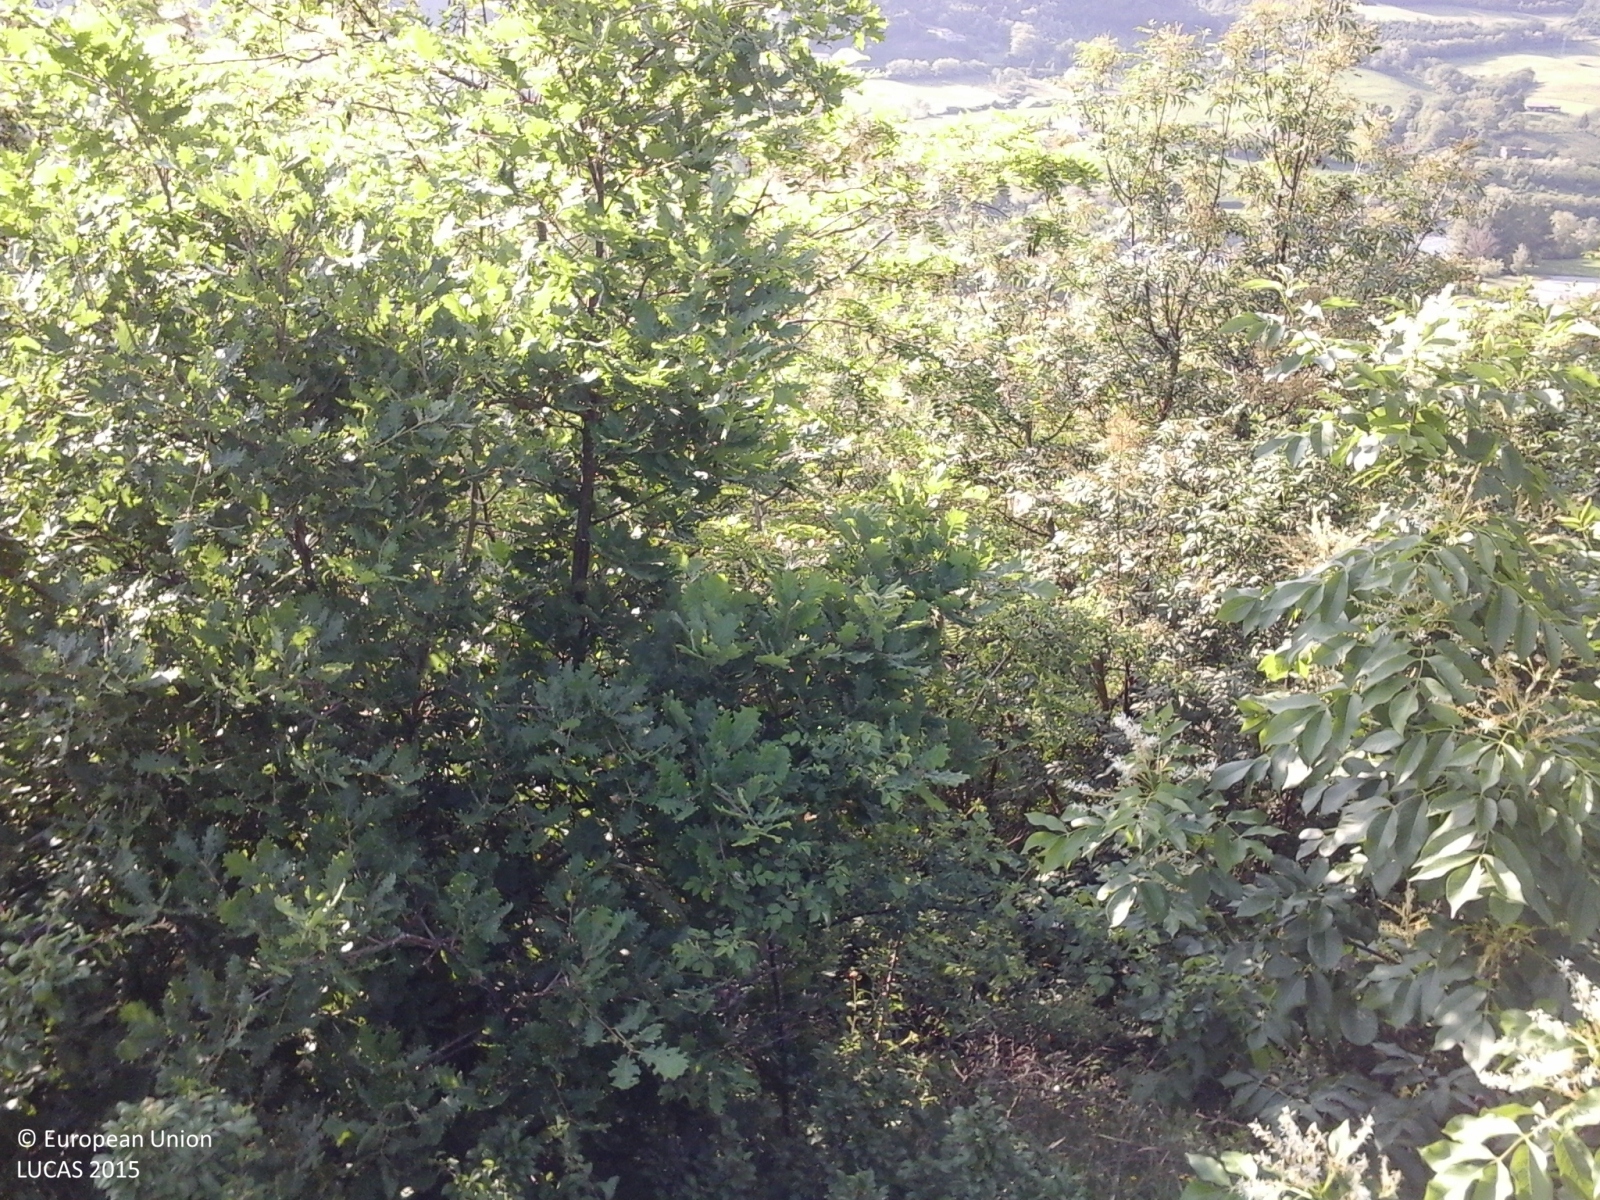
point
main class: Woodland
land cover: Broadleaved woodland
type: mesophytic deciduous forest
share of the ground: > 75 %
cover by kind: broadleaved forest trees 100 %
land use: Forestry
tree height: > 5 m
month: May
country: IT
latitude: 44.7635
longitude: 9.3822
